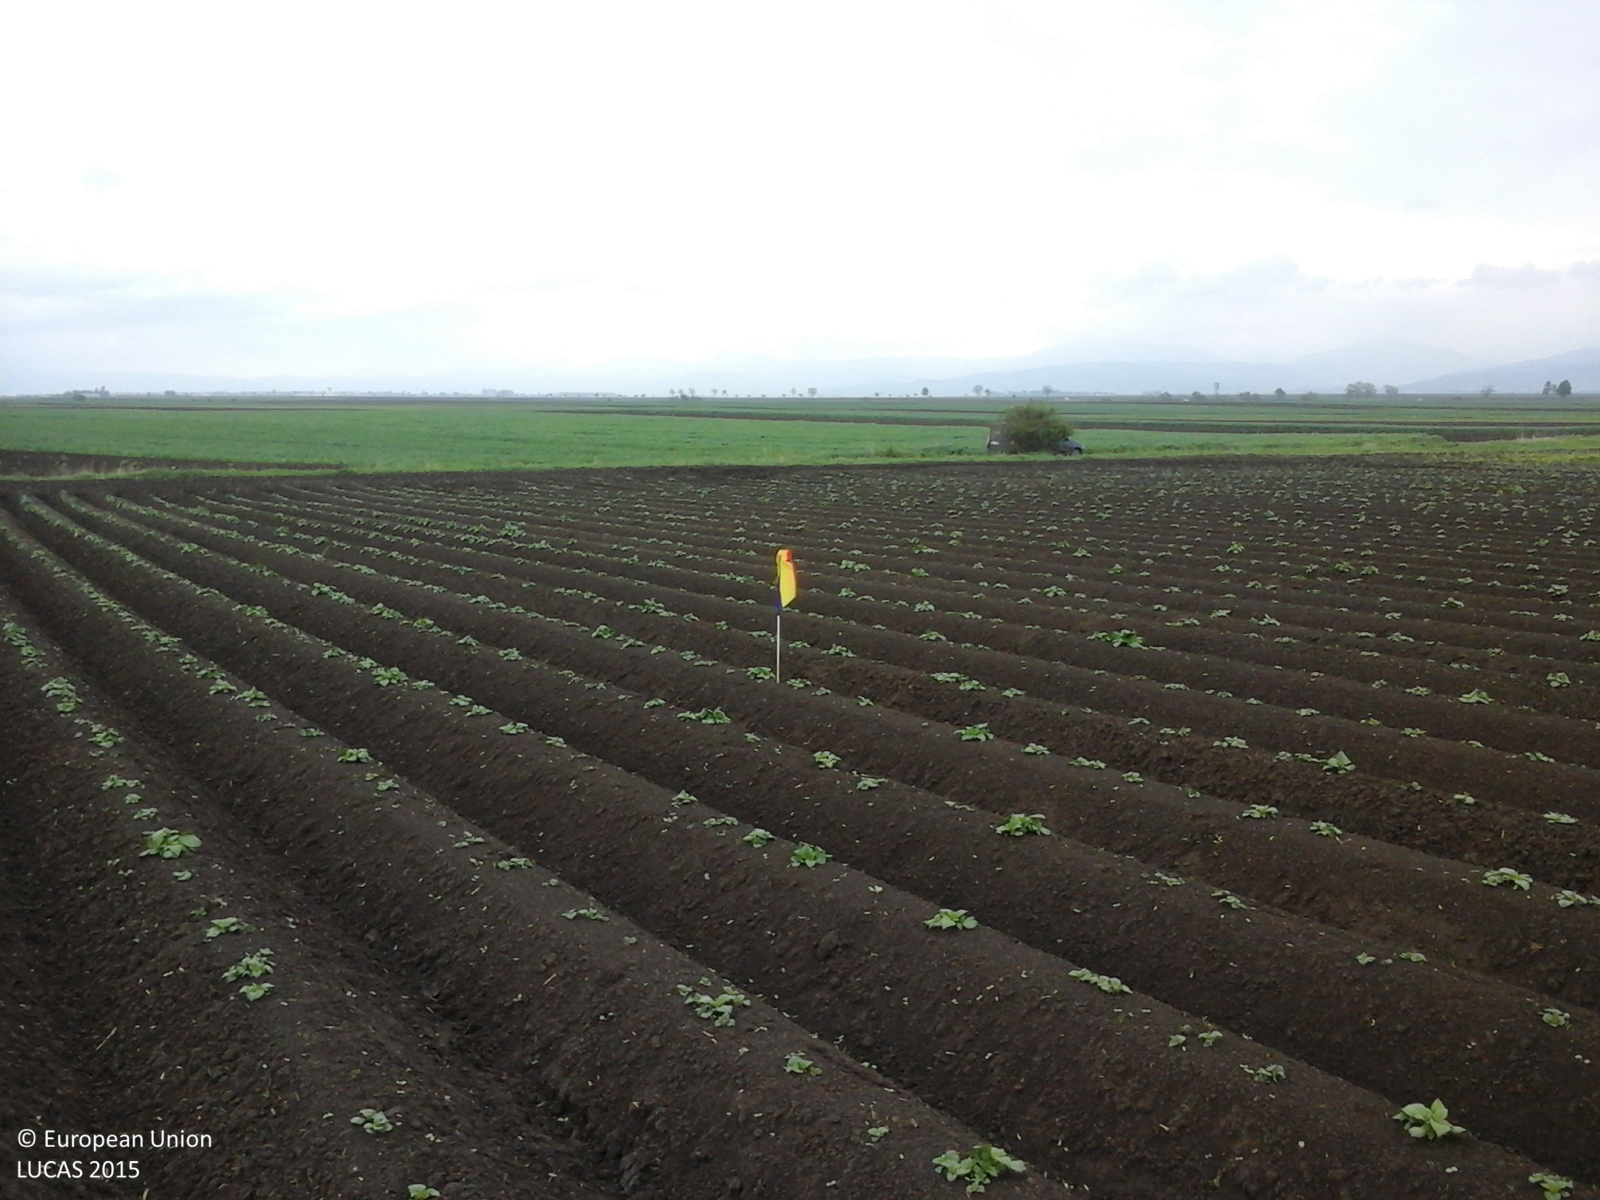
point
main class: Cropland
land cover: Potatoes
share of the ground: 10 - 25 %
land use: Agriculture (excluding fallow land and kitchen gardens)
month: May
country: RO
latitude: 45.9722
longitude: 26.0571
